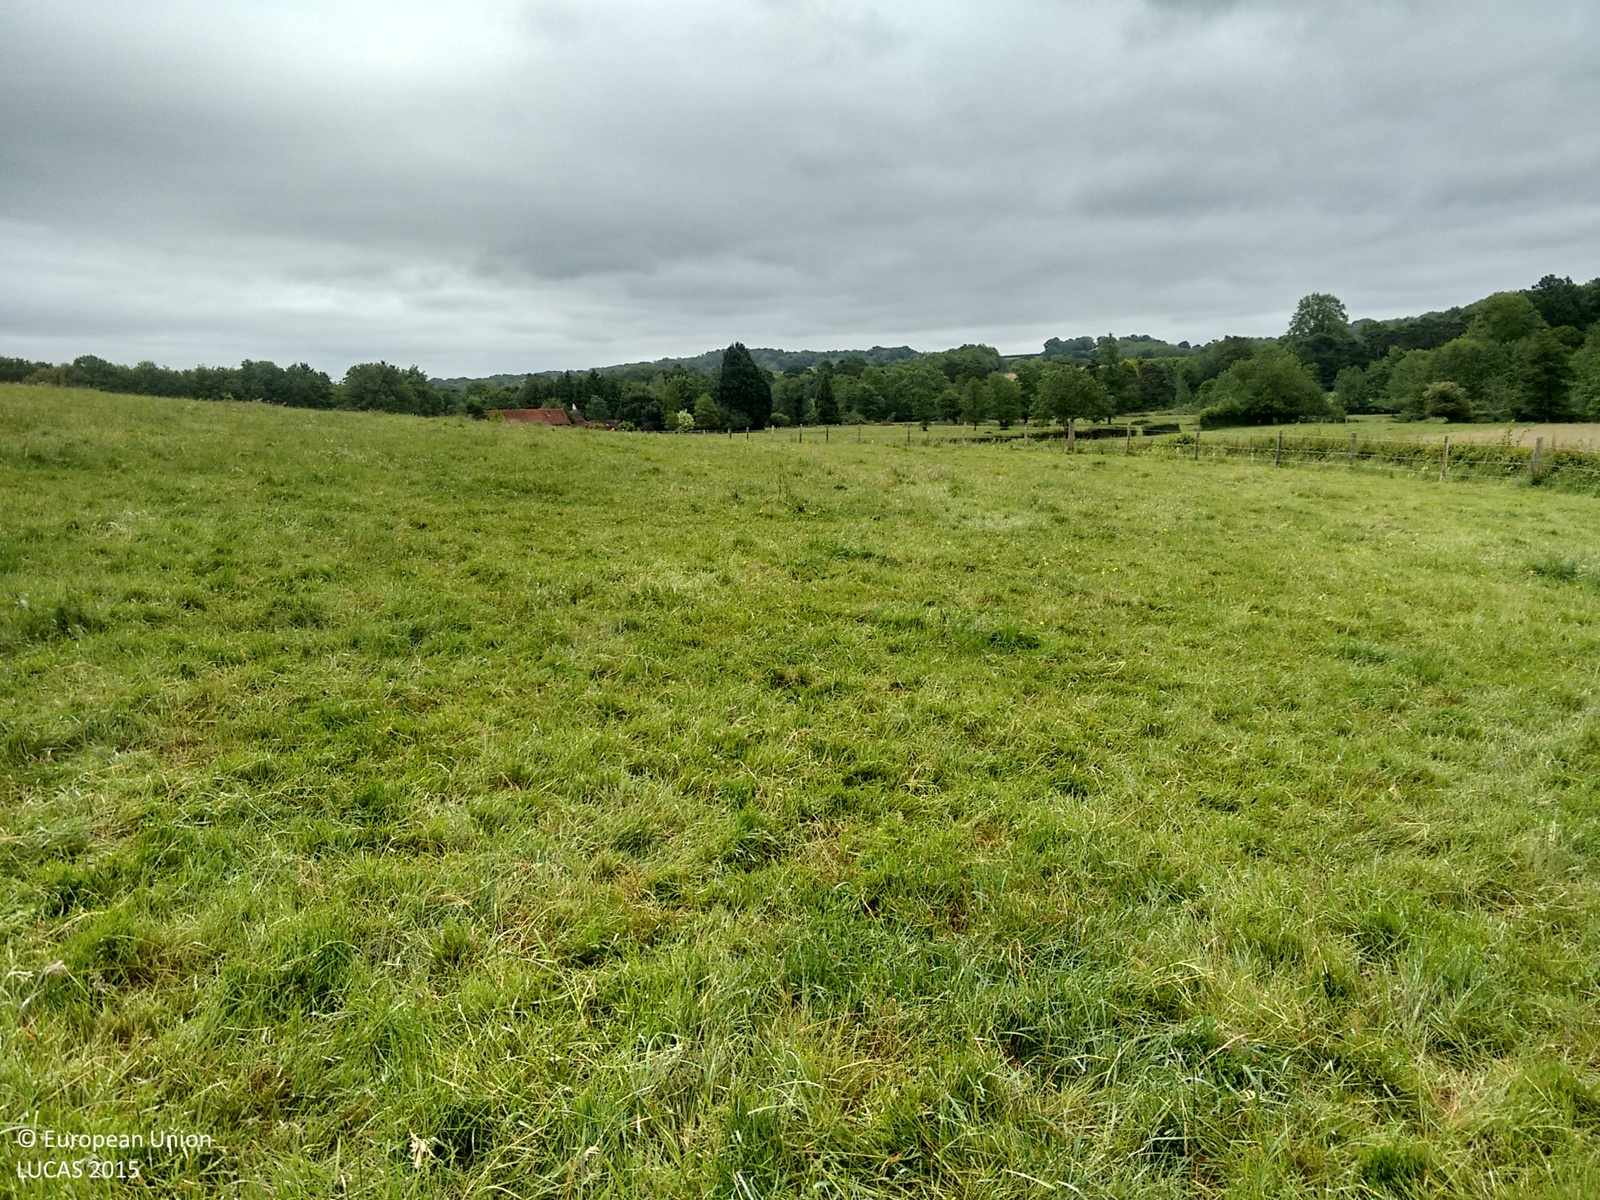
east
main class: Grassland
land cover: Grassland without tree/shrub cover
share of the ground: > 75 %
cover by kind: herbaceous plants 100 %
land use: Agriculture (excluding fallow land and kitchen gardens)
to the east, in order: Grassland without tree/shrub cover; Managed hedges; Grass margins; Paved roads, cycling and walking lanes; Grass margins; Managed hedges; Grassland without tree/shrub cover
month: June
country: GB
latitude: 50.9902
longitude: 0.3830
